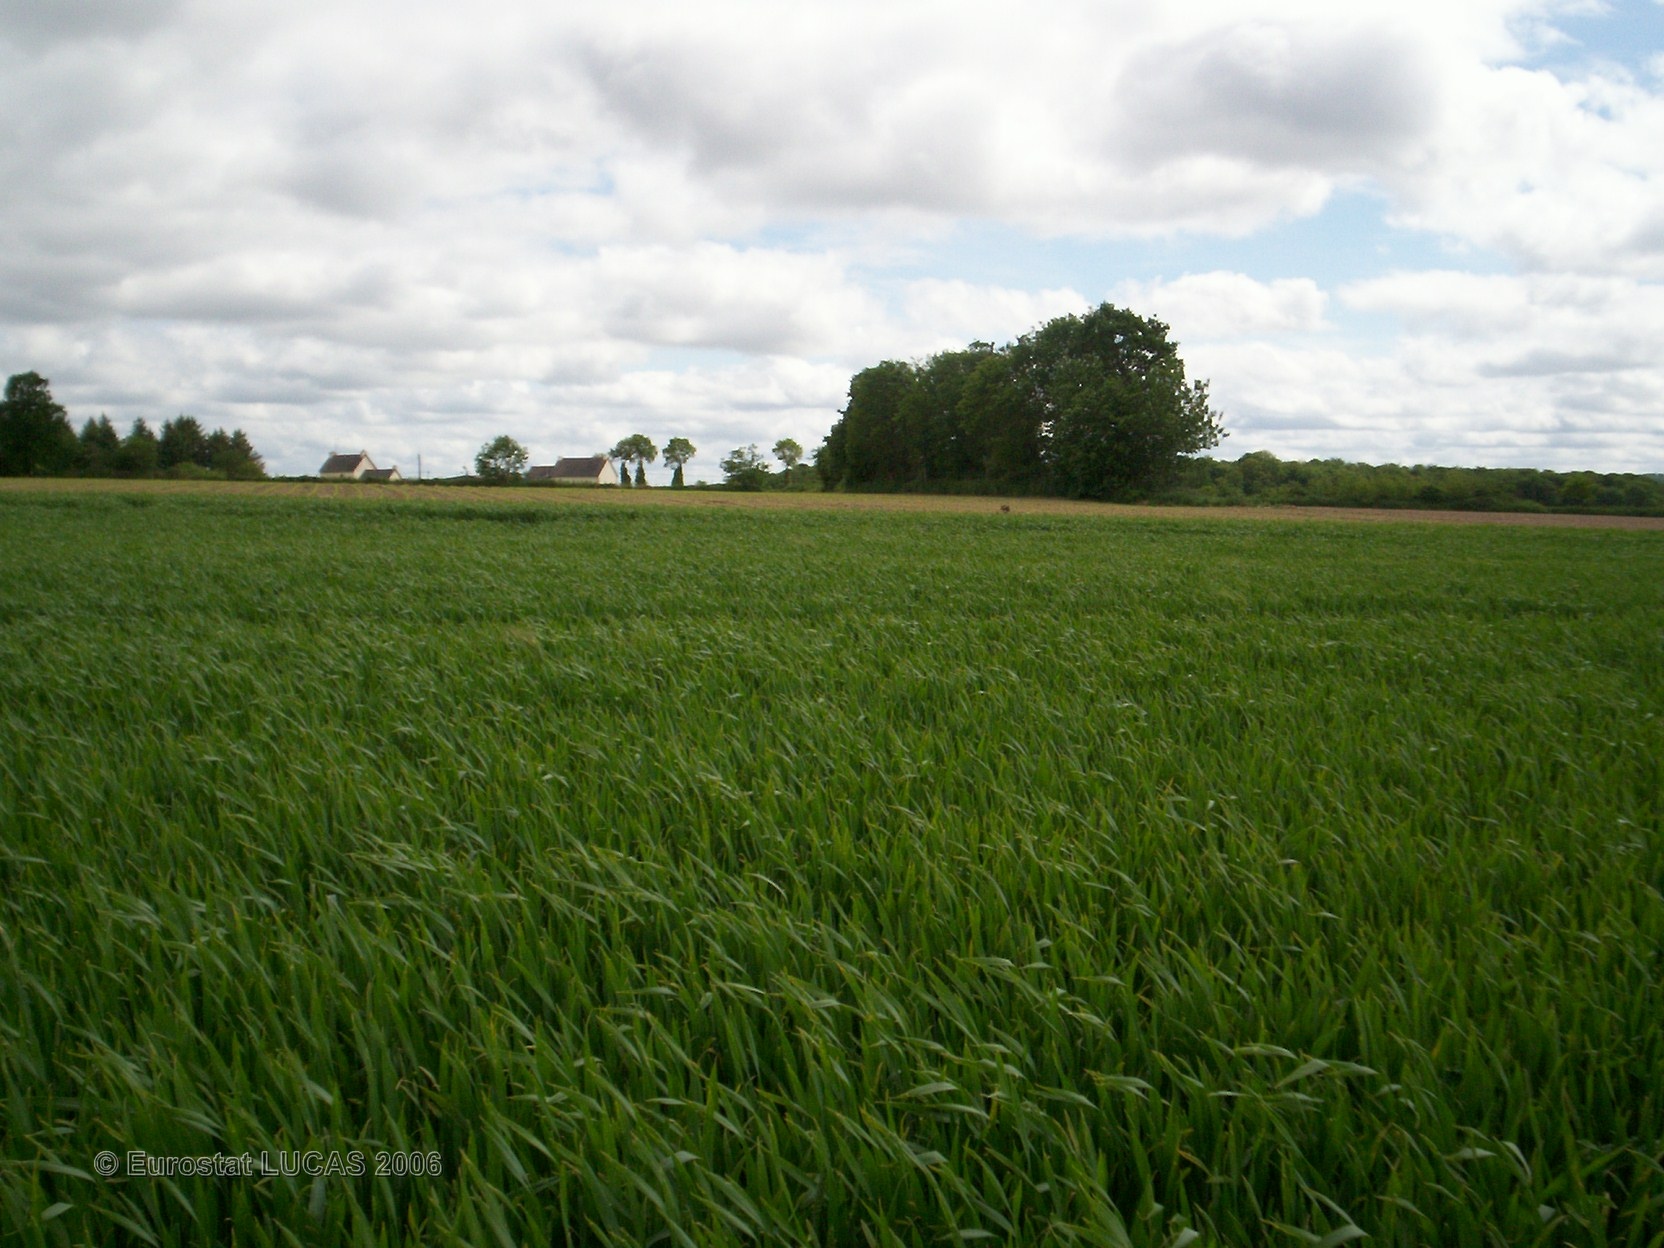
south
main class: Cropland
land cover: Common wheat
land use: Agriculture (excluding fallow land and kitchen gardens)
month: May
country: FR
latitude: 48.3597
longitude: -2.3816
